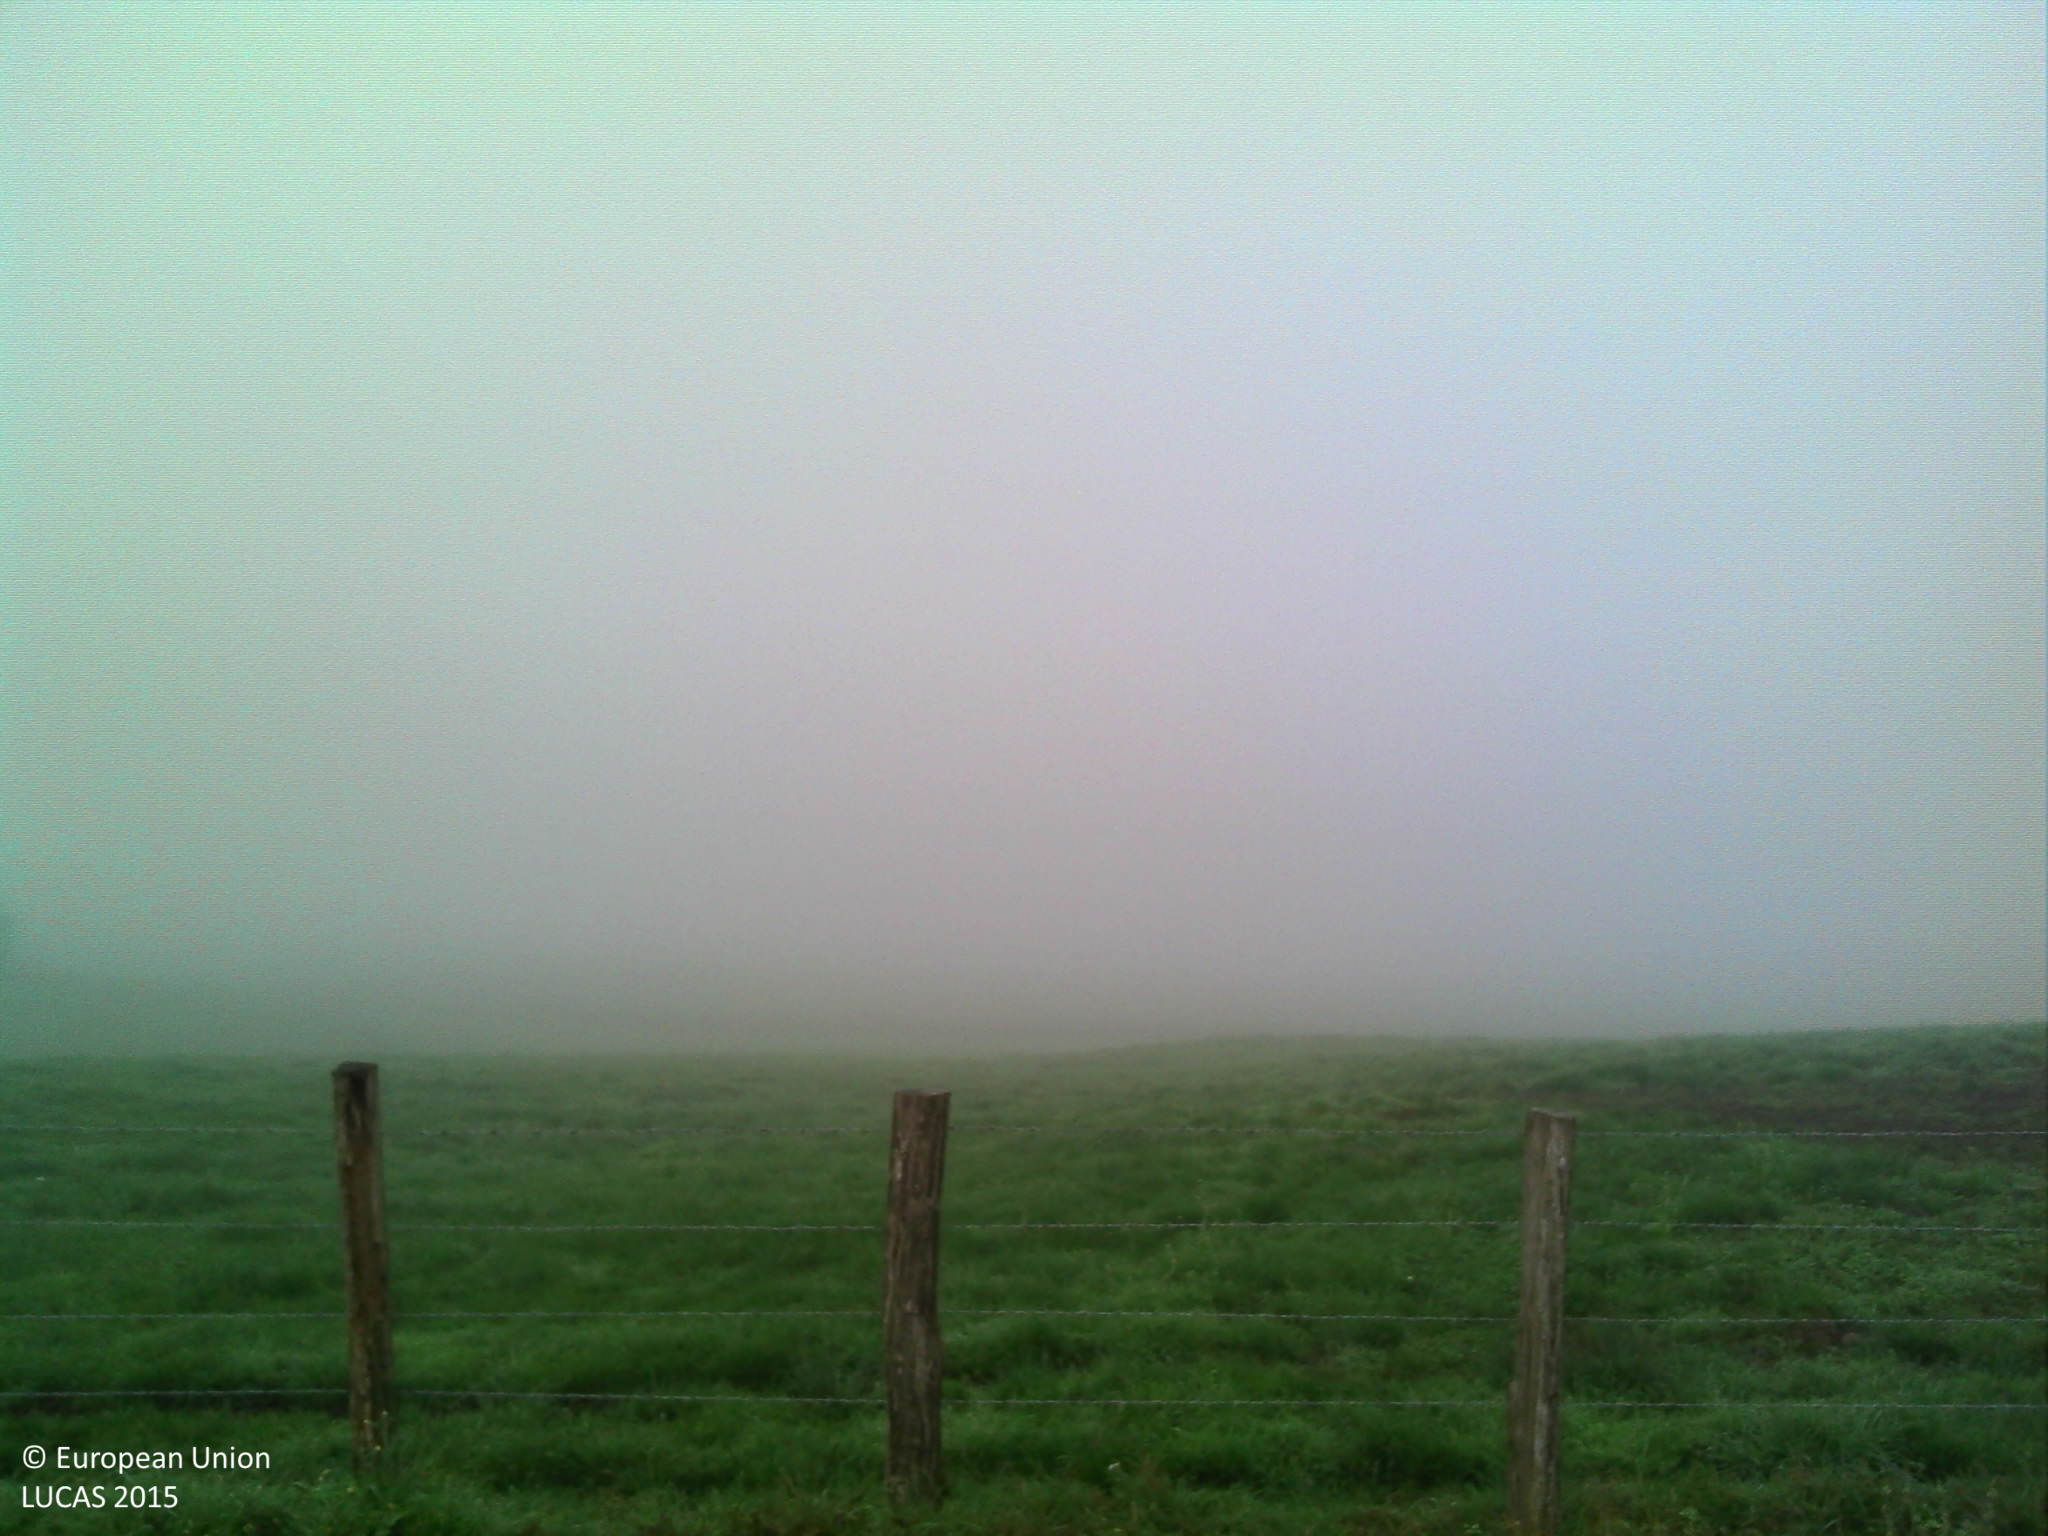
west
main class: Grassland
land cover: Grassland without tree/shrub cover
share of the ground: > 75 %
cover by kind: herbaceous plants 100 %
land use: Agriculture (excluding fallow land and kitchen gardens)
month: October
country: FR
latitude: 46.3376
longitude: 5.2868
